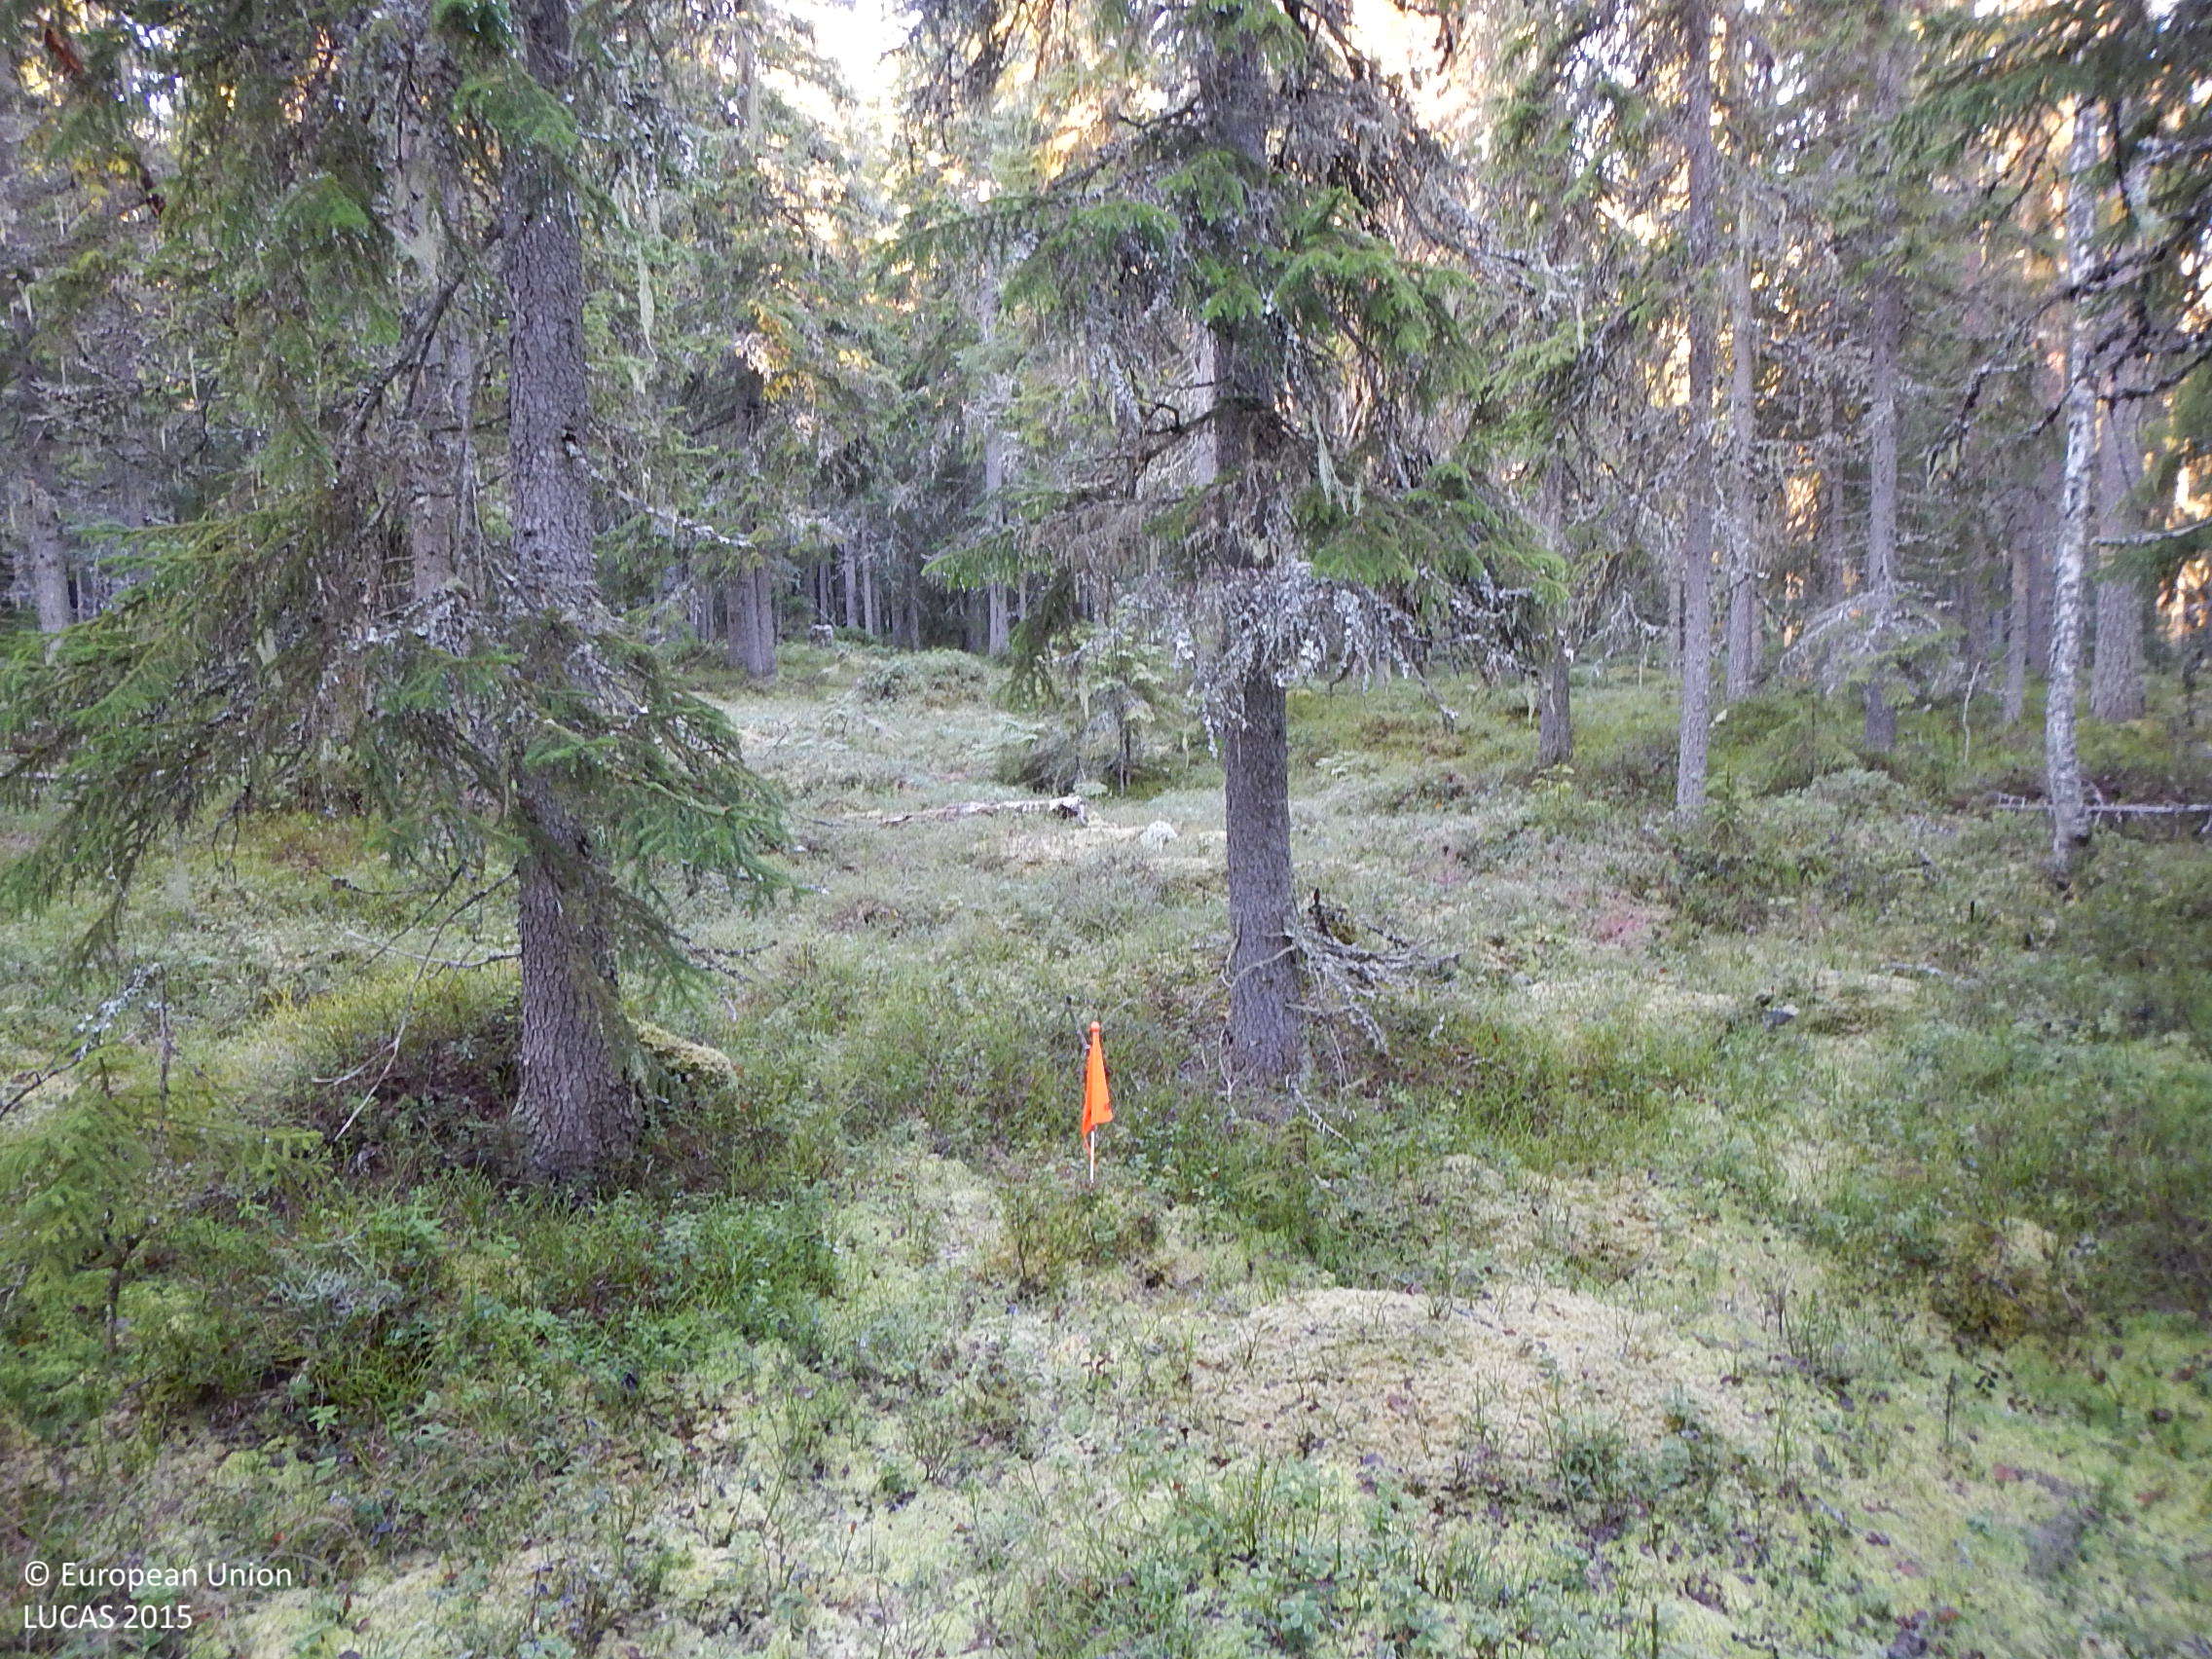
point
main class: Woodland
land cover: Spruce dominated coniferous woodland
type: boreal forest
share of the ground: 50 - 75 %
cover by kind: coniferous forest trees 50 %, shrubs 30 %, lichens and mosses 20 %
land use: Forestry
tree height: > 5 m
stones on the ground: < 10 %
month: November
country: SE
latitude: 61.5920
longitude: 15.9188
